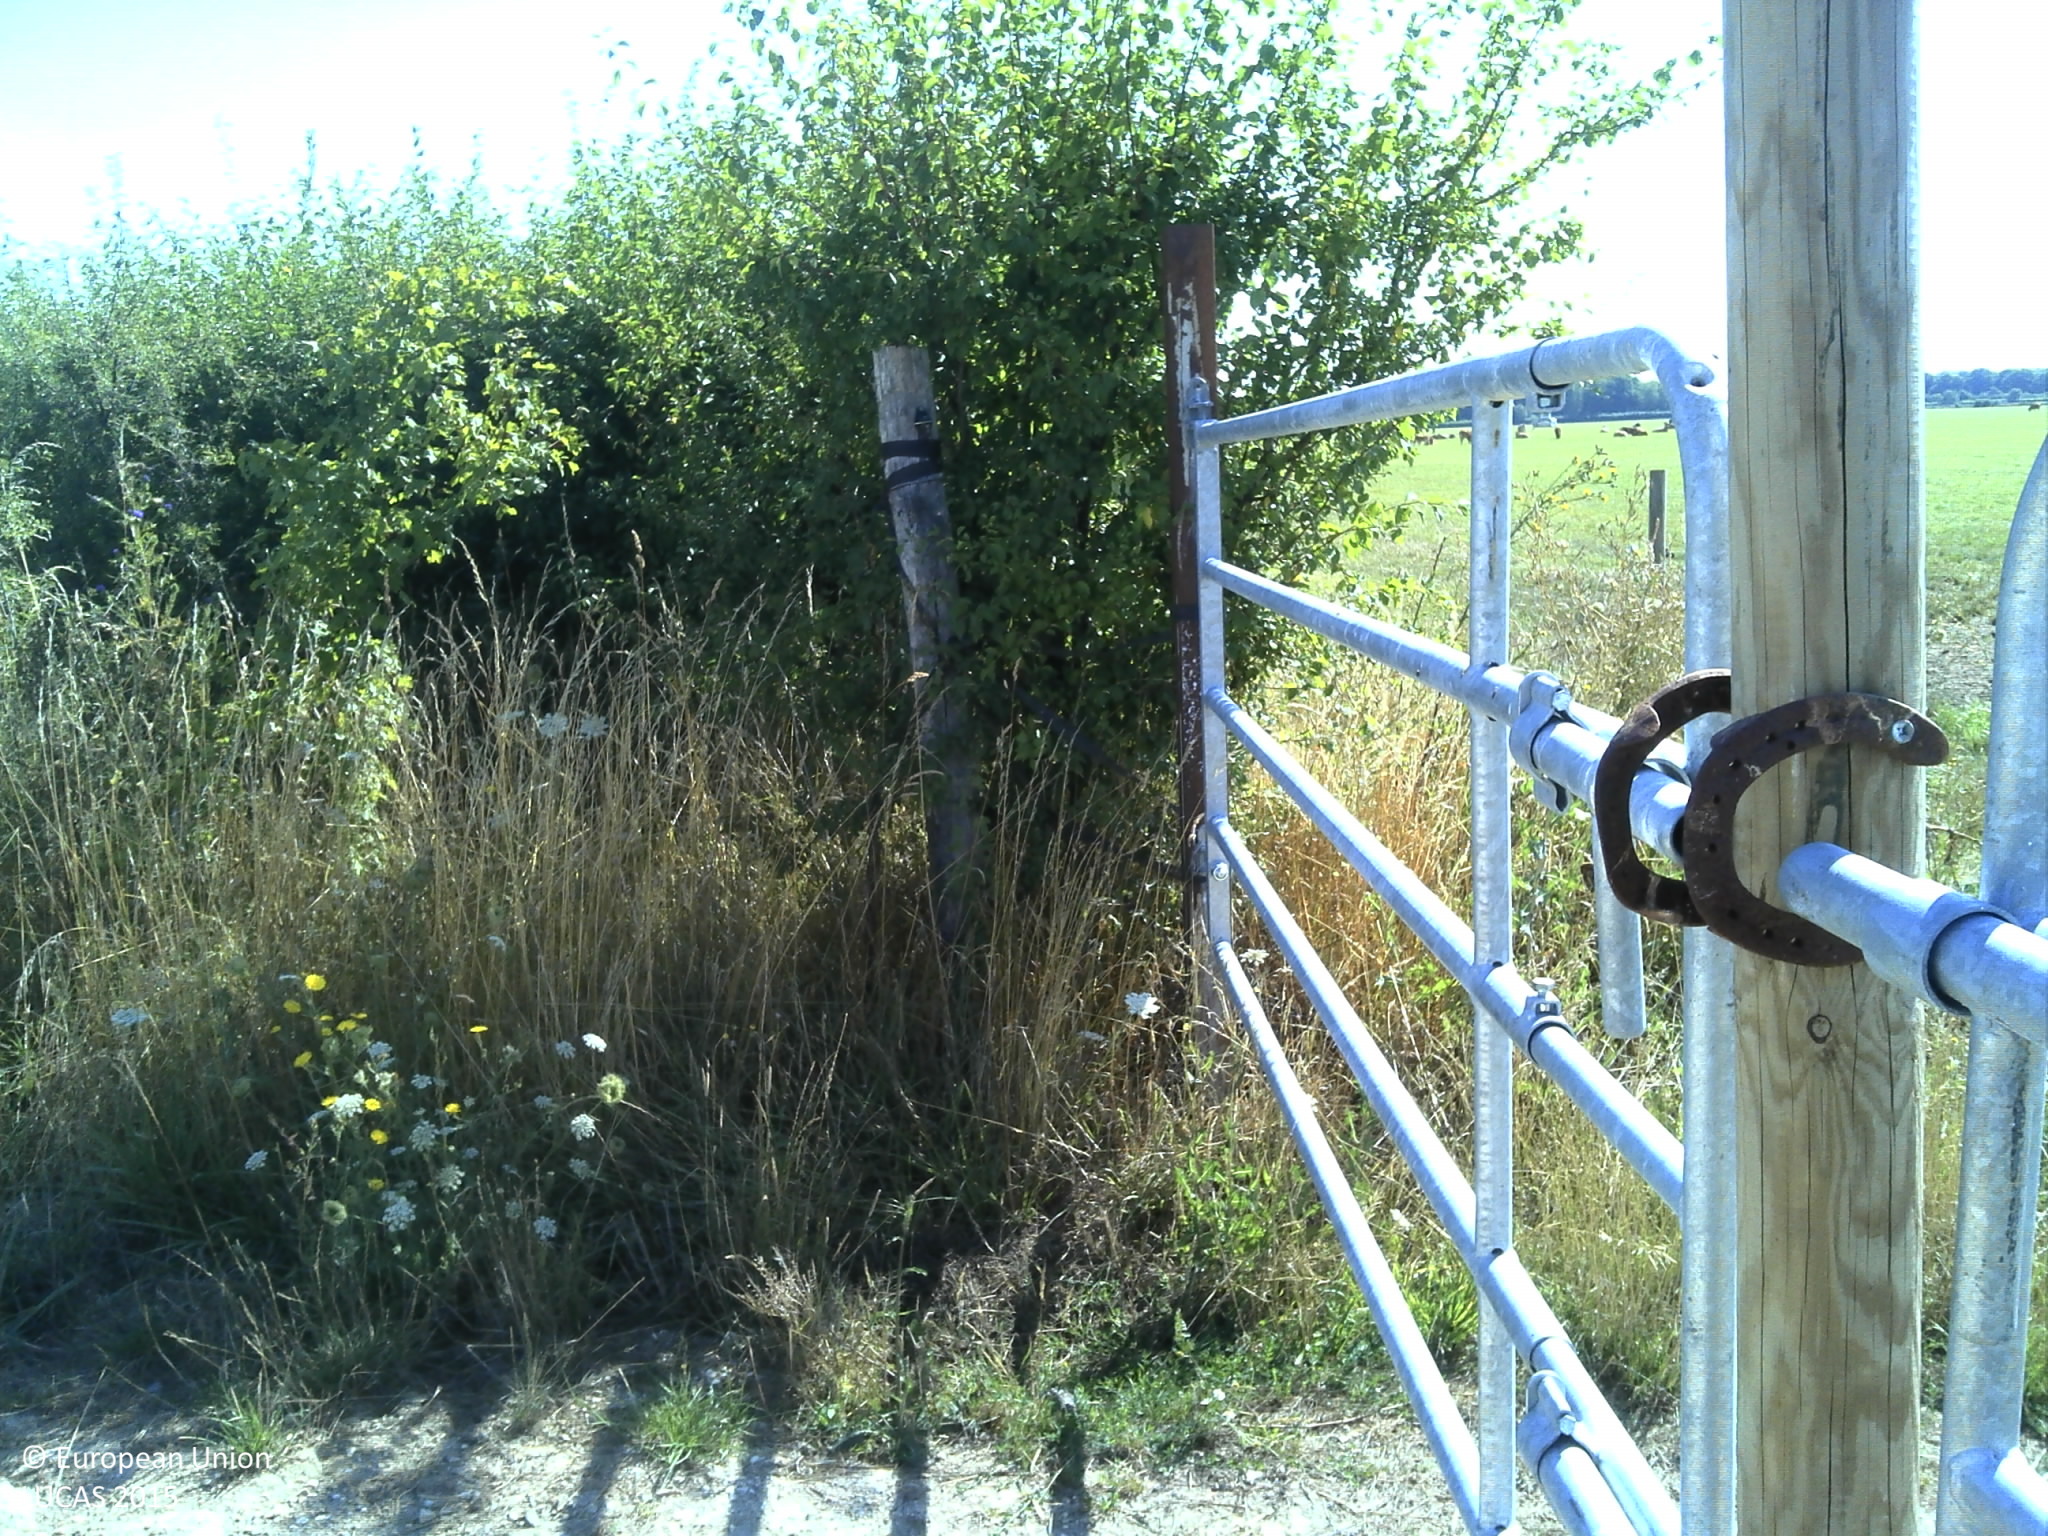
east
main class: Grassland
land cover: Grassland without tree/shrub cover
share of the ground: > 75 %
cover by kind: herbaceous plants 100 %
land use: Agriculture (excluding fallow land and kitchen gardens)
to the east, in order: Grassland without tree/shrub cover
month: August
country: FR
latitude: 48.6670
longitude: 1.9064
